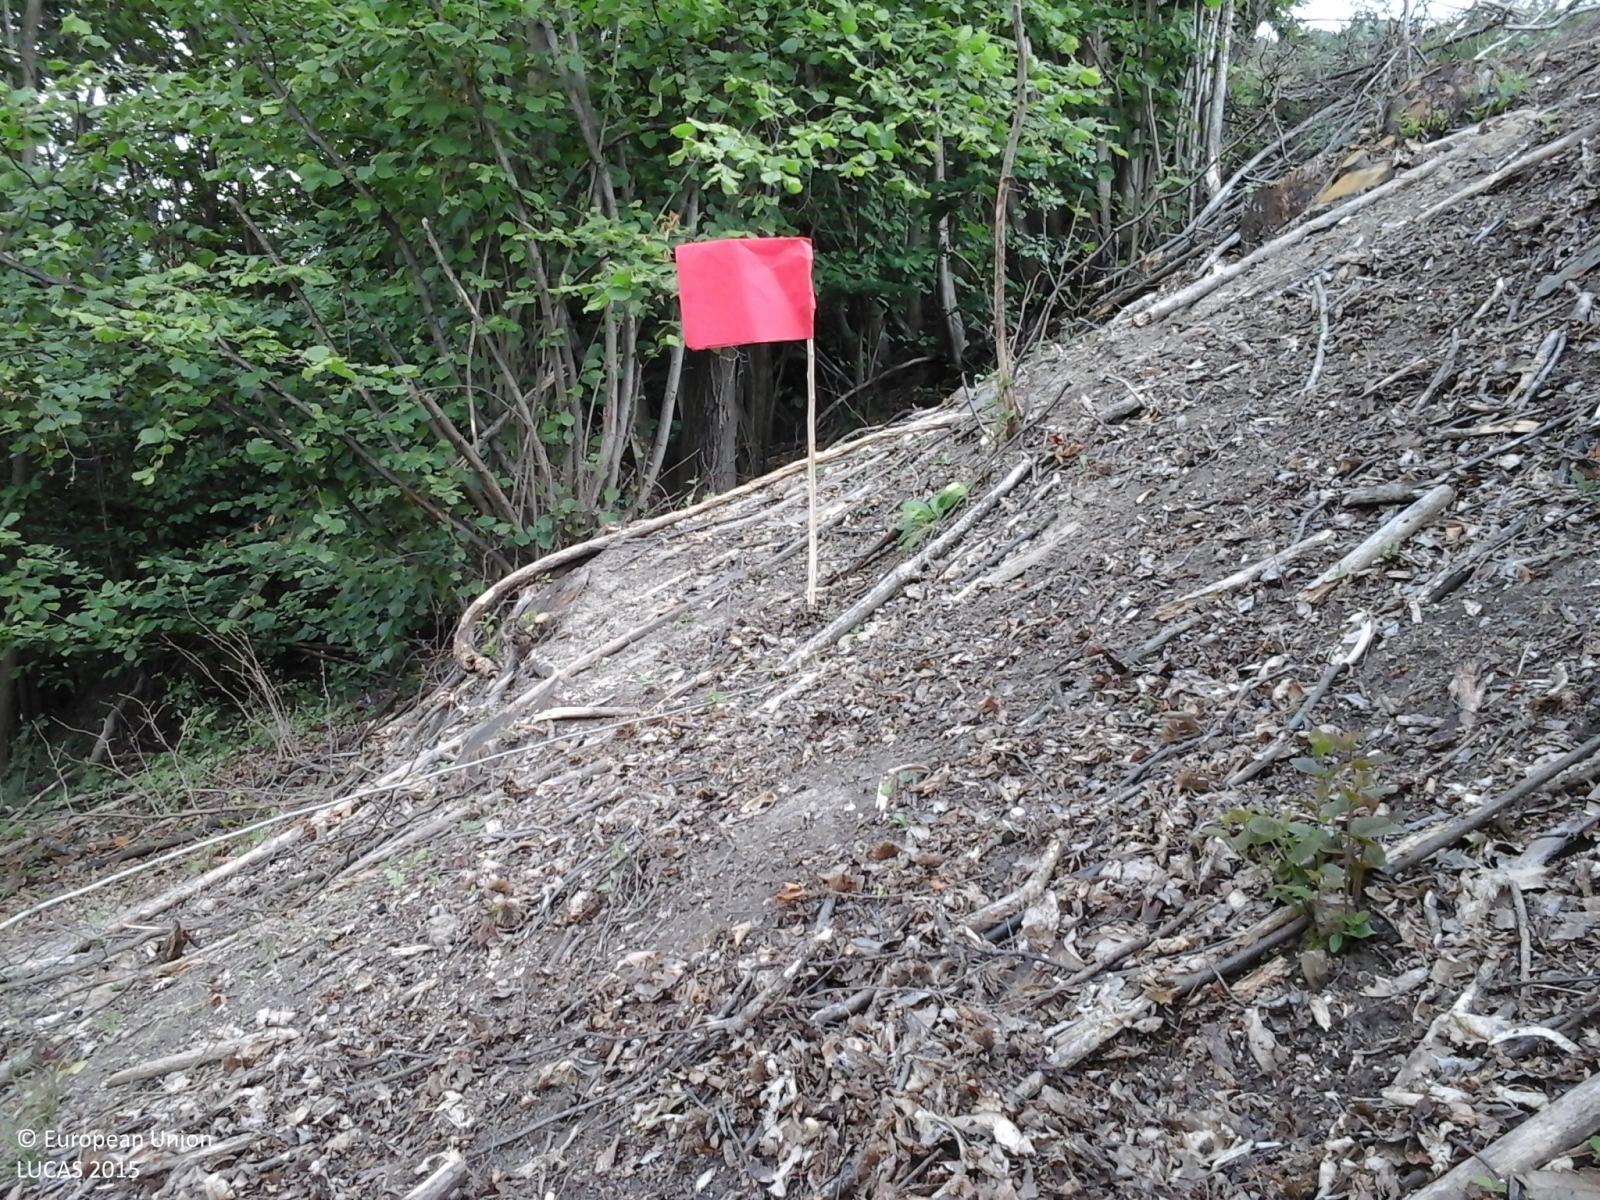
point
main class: Woodland
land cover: Broadleaved woodland
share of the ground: < 10 %
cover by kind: herbaceous plants 30 %, consolidated bare surface 30 %, broadleaved forest trees 20 %, shrubs 20 %
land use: Forestry
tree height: < 5 m
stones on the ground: 25 - 50 %
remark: Clear cut
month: June
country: IT
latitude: 44.5735
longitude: 8.4544
